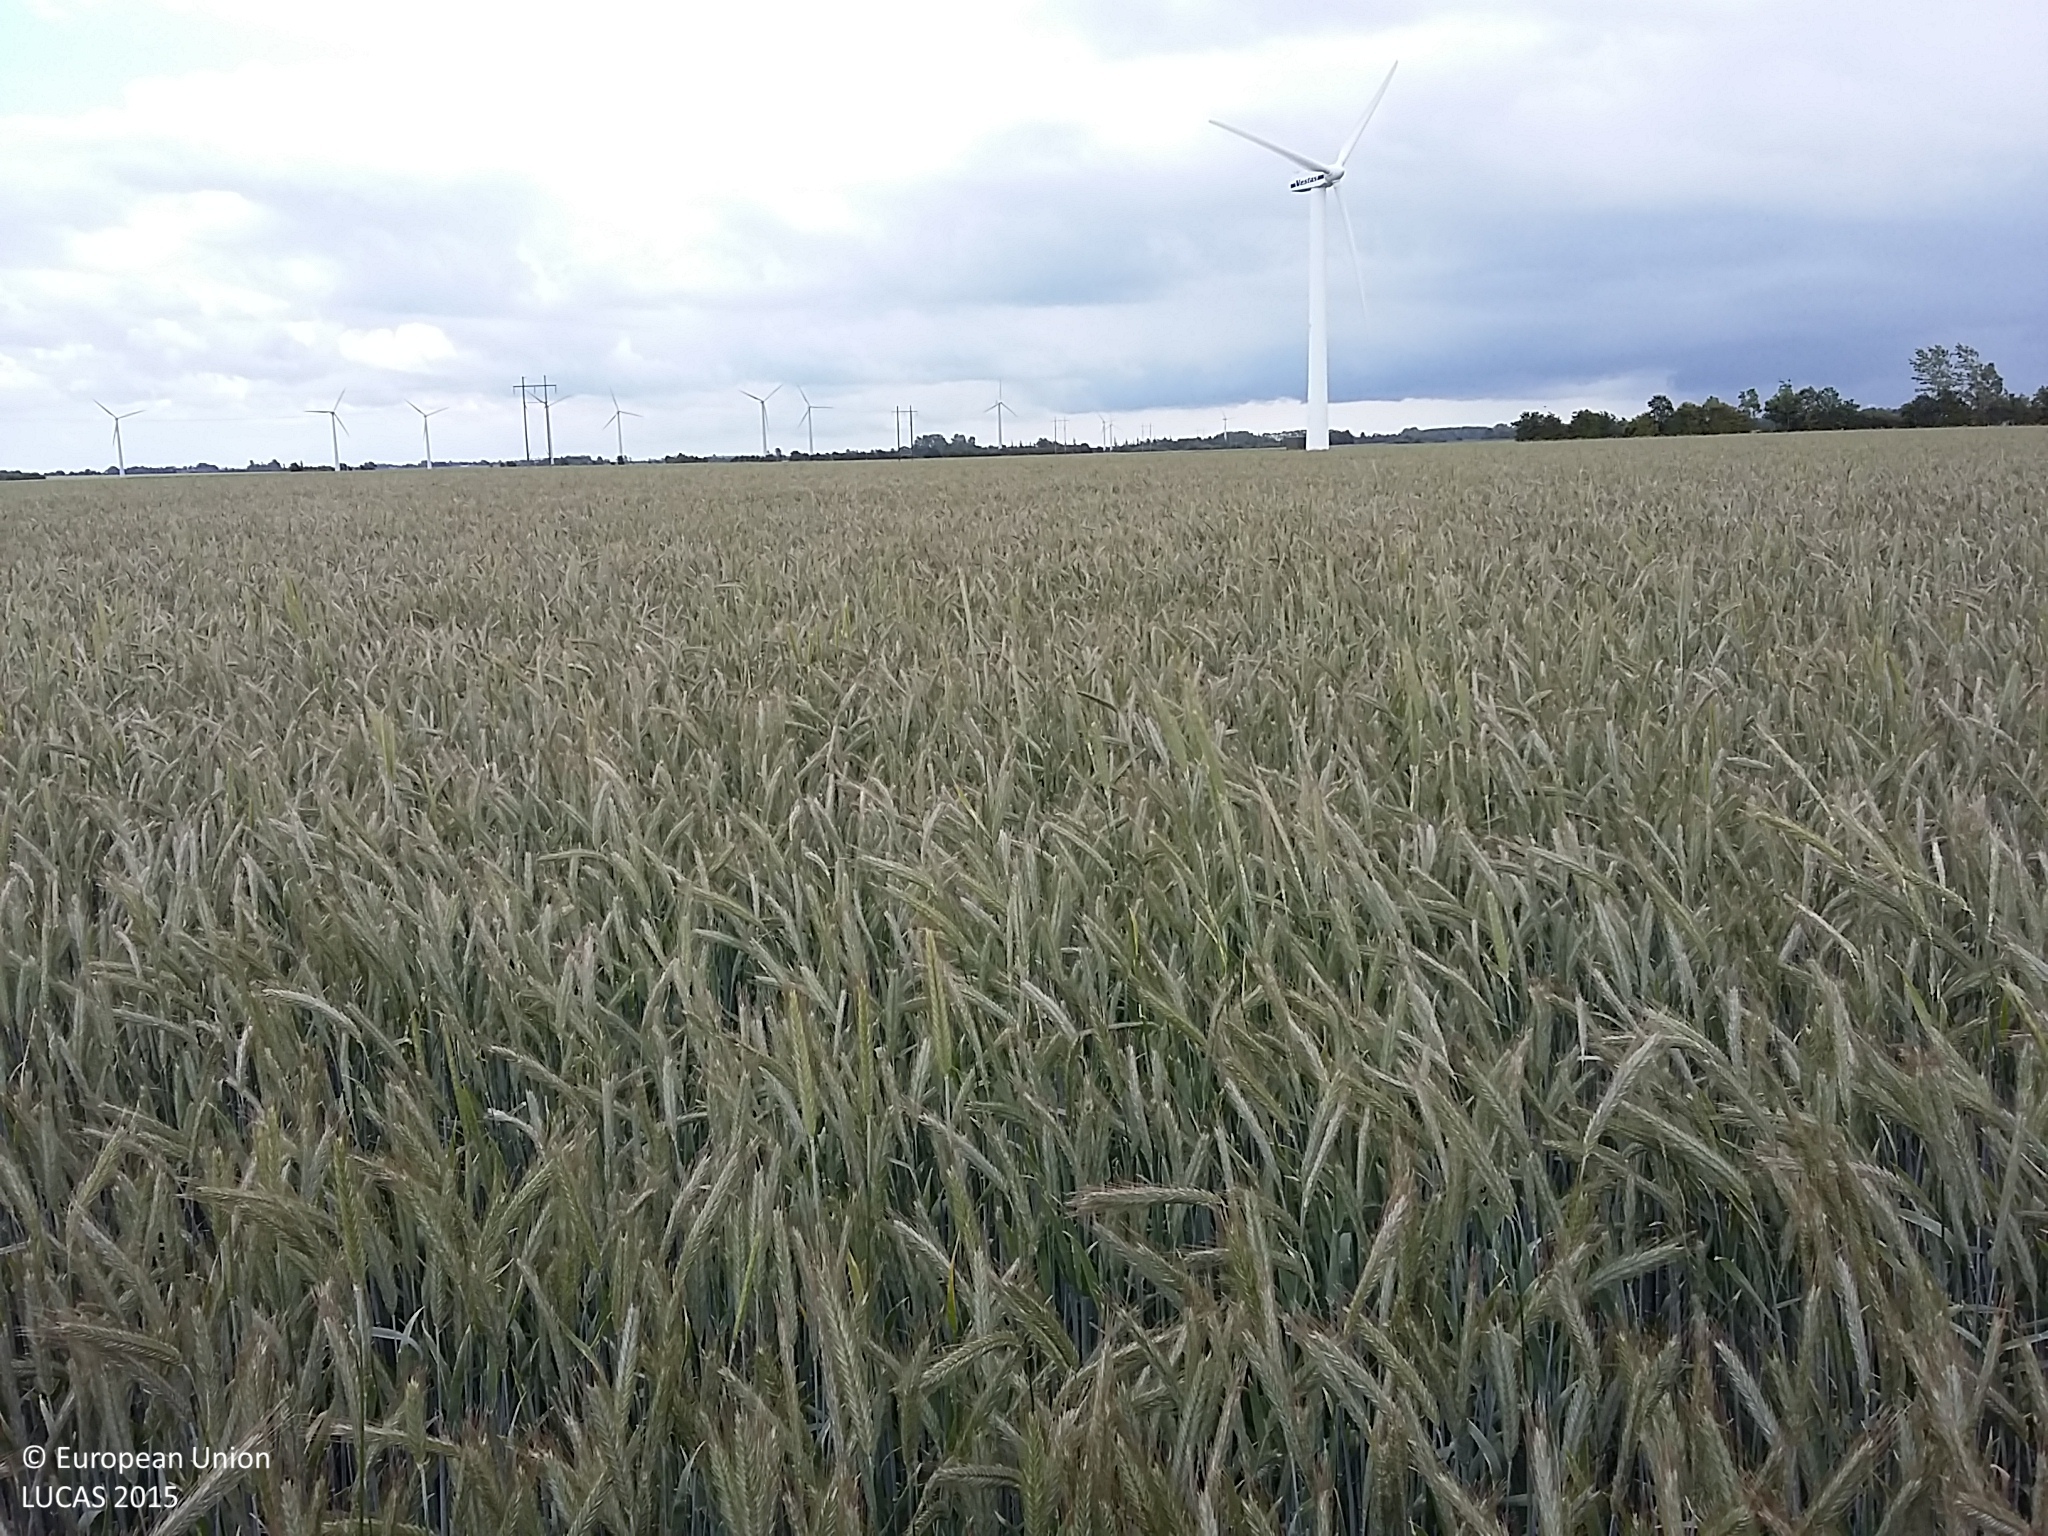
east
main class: Cropland
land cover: Rye
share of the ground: > 75 %
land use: Agriculture (excluding fallow land and kitchen gardens)
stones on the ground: < 10 %
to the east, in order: Rye; Barley; Common wheat; Electric lines; Common wheat
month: June
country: DK
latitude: 54.7435
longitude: 11.2574
